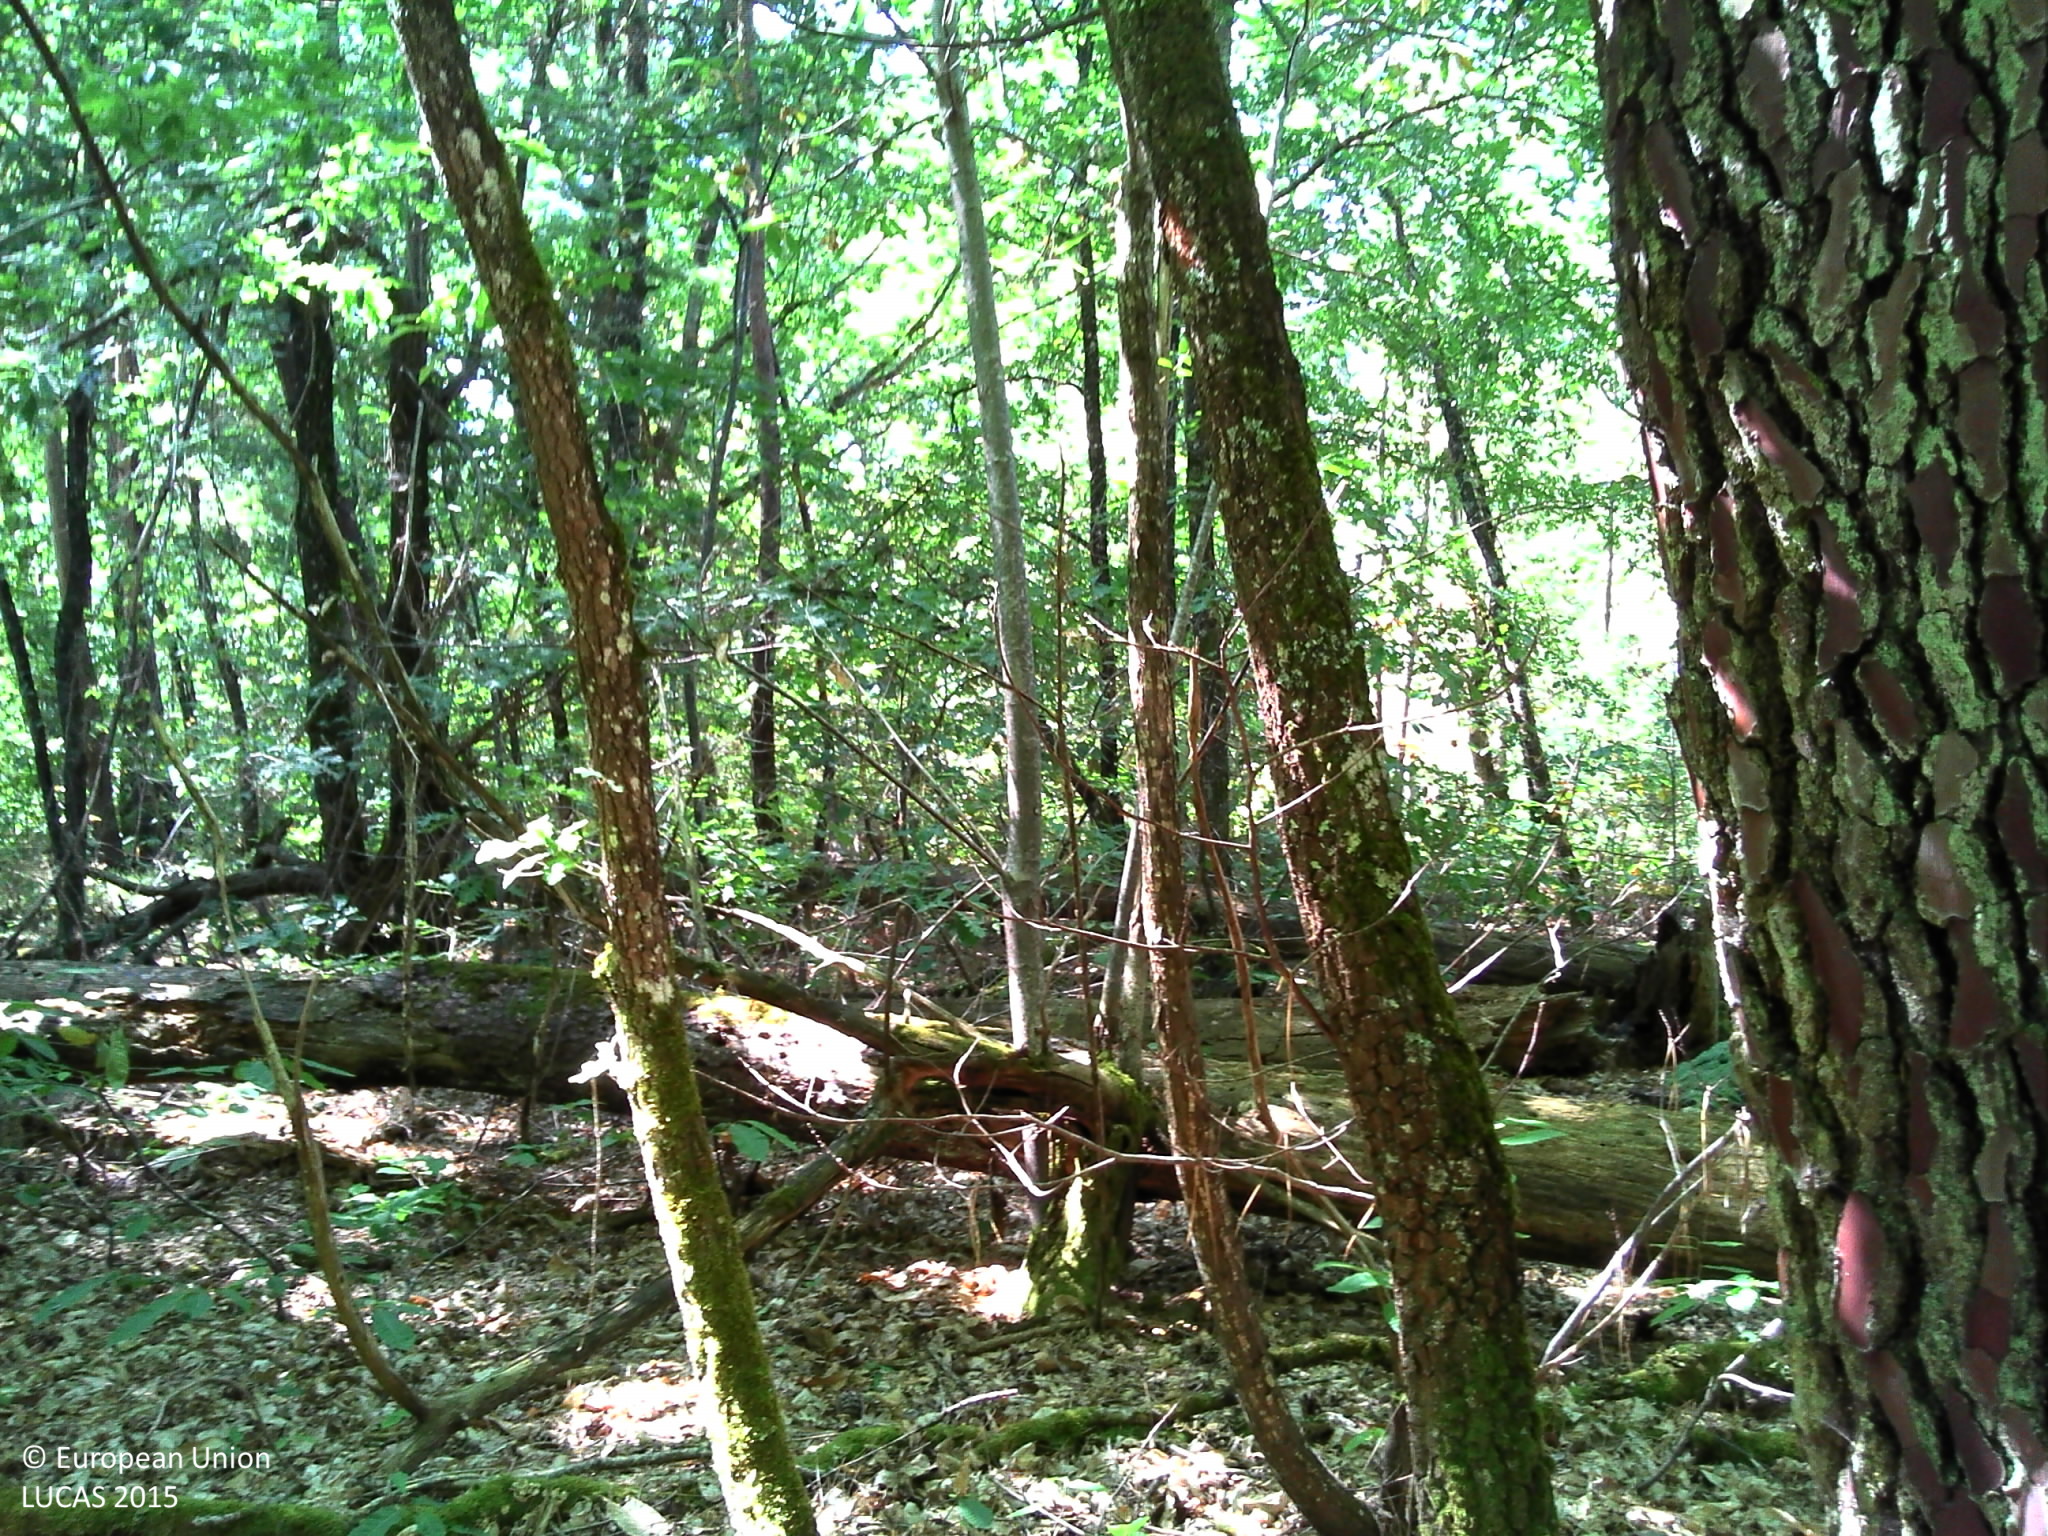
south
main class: Woodland
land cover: Broadleaved woodland
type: acidophilous oak and oak-birch forest
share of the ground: > 75 %
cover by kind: broadleaved forest trees 80 %, herbaceous plants 10 %, shrubs 5 %, lichens and mosses 5 %
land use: Forestry
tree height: > 5 m
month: July
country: FR
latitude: 44.9167
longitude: 0.5530
